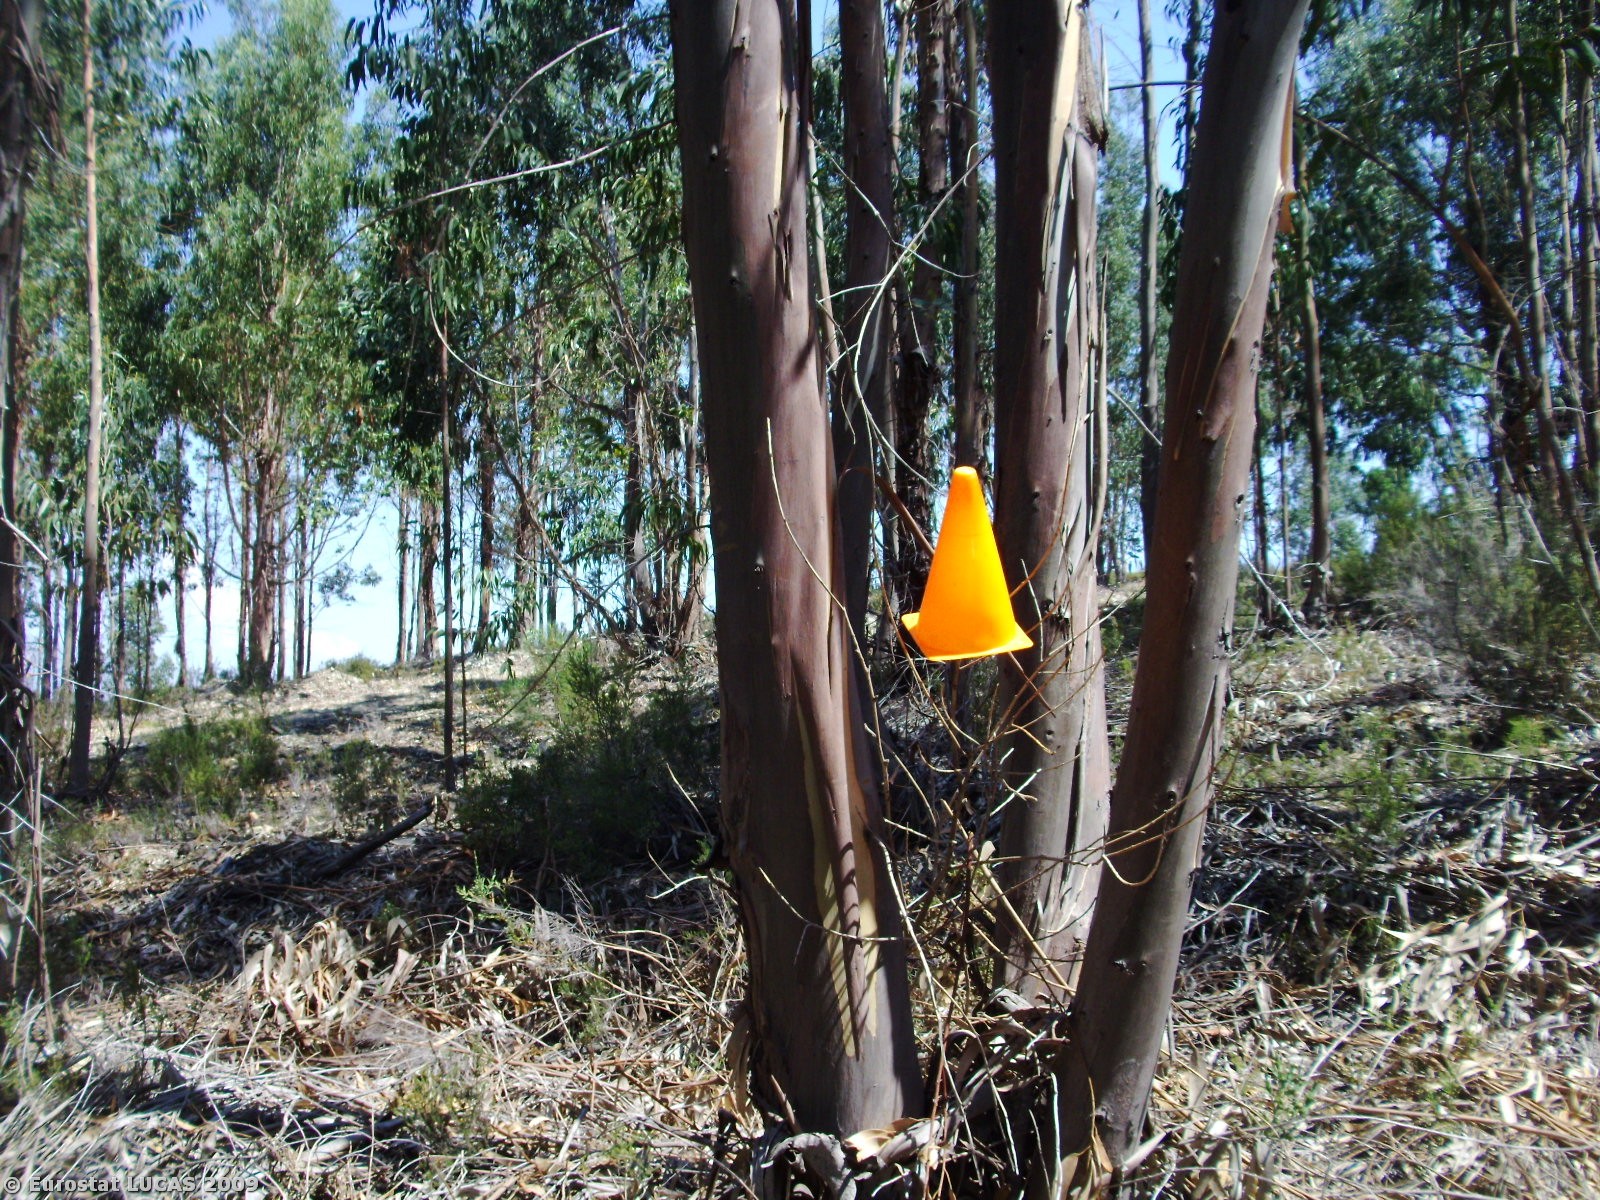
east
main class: Woodland
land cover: Broadleaved woodland
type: plantations and self-sown exotic forest
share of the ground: > 75 %
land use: Forestry
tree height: > 5 m
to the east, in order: Broadleaved woodland; Tracks; Broadleaved woodland
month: August
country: PT
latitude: 40.1553
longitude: -7.6121
